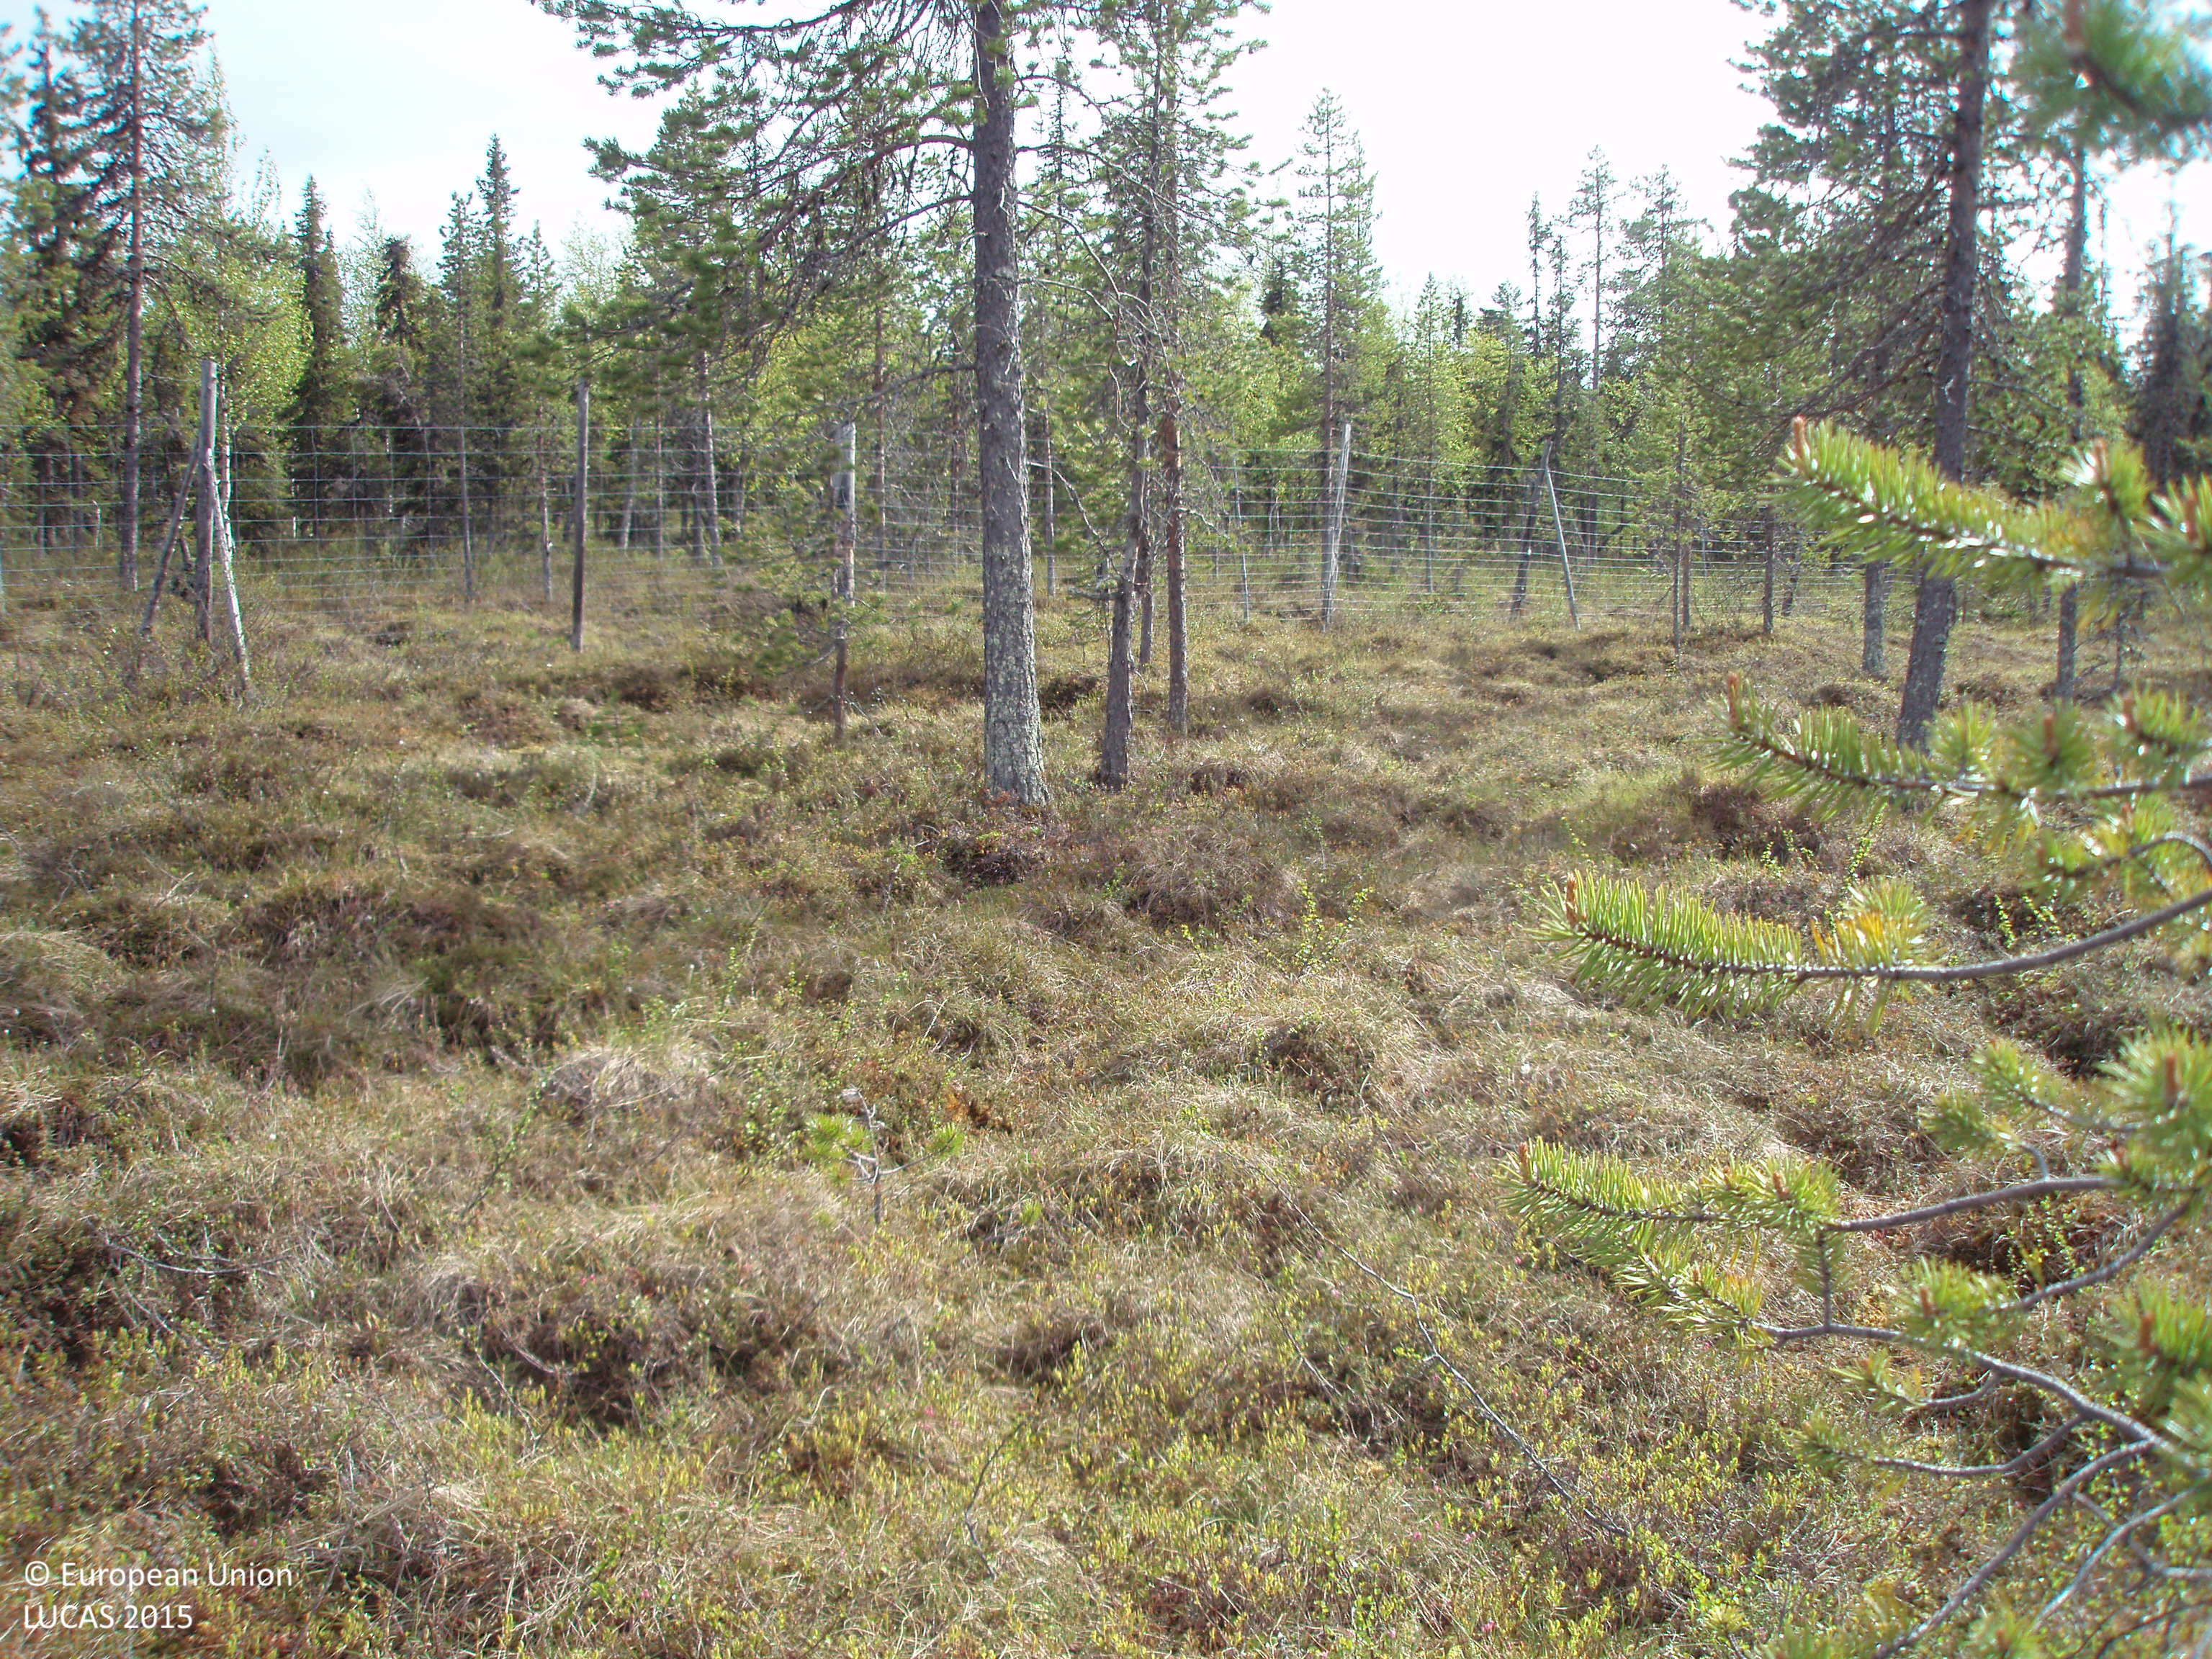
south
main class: Woodland
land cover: Pine dominated coniferous woodland
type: mire and swamp forests
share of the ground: 10 - 25 %
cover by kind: shrubs 50 %, lichens and mosses 20 %, coniferous forest trees 15 %, herbaceous plants 10 %, broadleaved forest trees 5 %
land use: Semi-natural and natural areas not in use
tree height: > 5 m
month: June
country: FI
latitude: 67.9756
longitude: 26.8222
